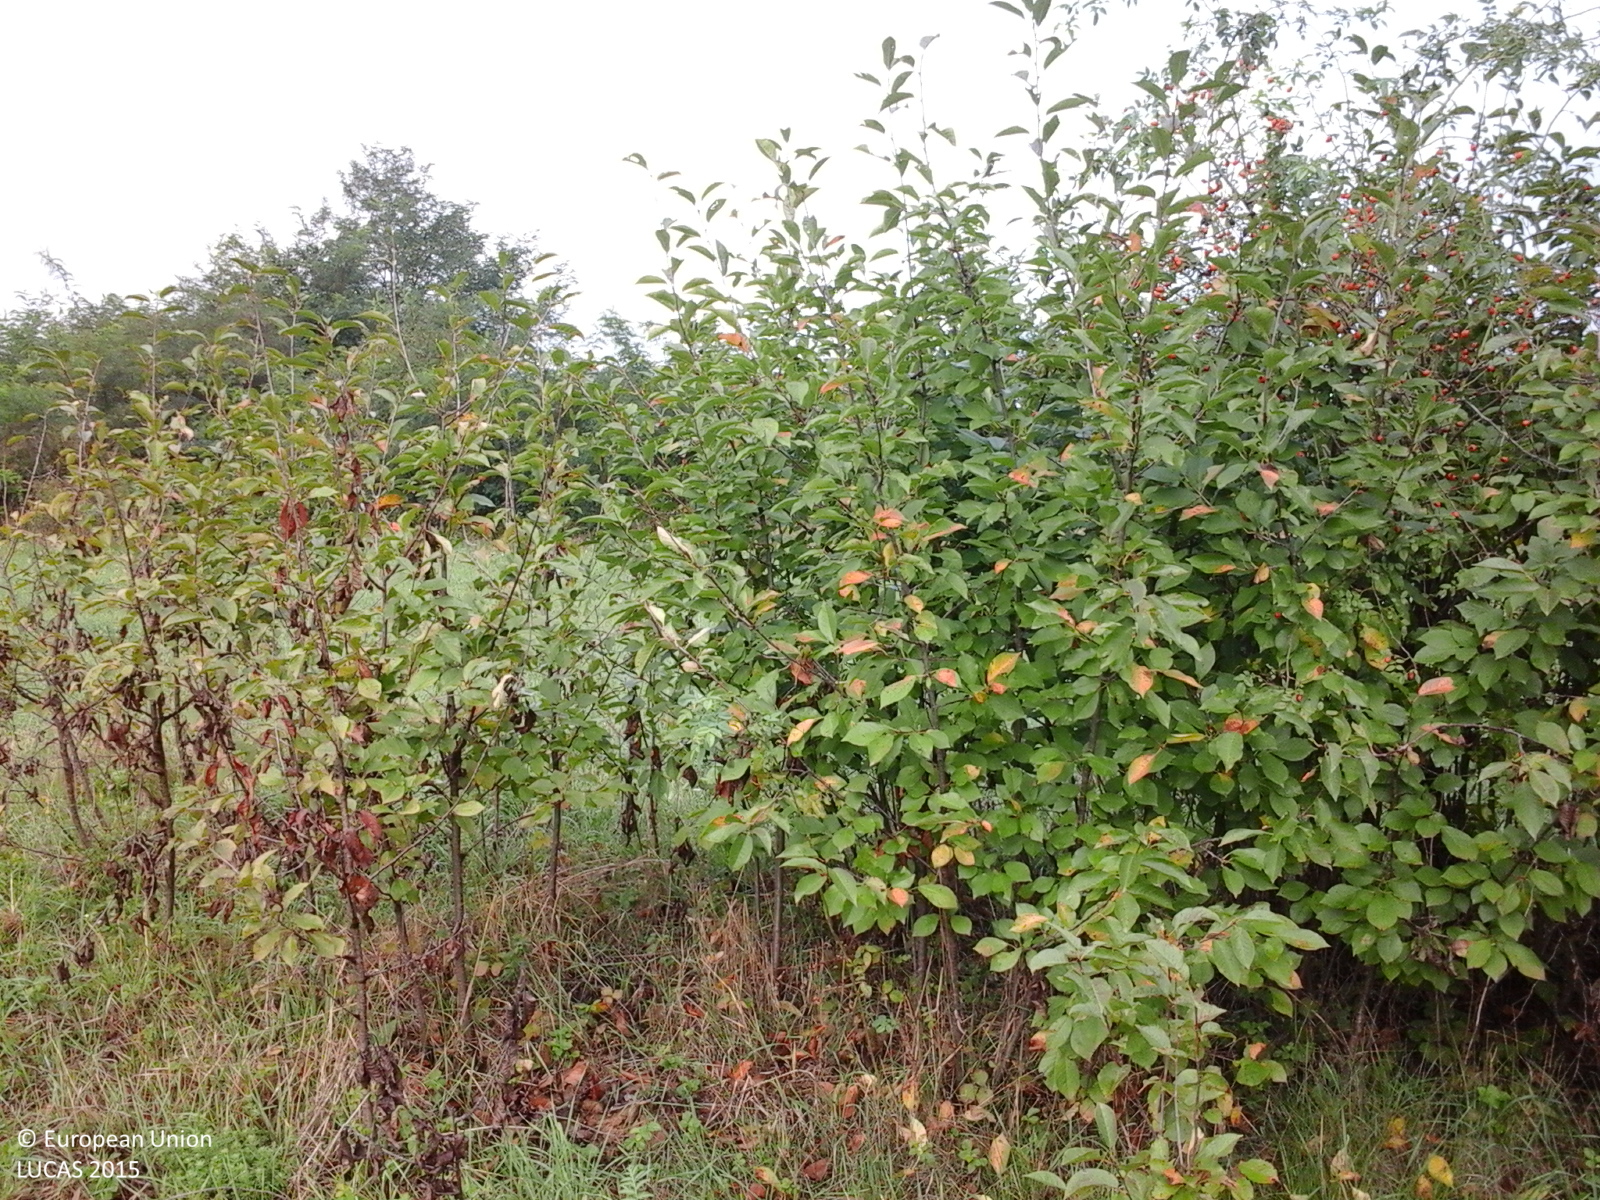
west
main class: Grassland
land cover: Grassland with sparse tree/shrub cover
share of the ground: > 75 %
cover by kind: herbaceous plants 85 %, shrubs 10 %, broadleaved forest trees 5 %
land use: Agriculture (excluding fallow land and kitchen gardens)
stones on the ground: < 10 %
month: September
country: RO
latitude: 46.7168
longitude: 21.7773
